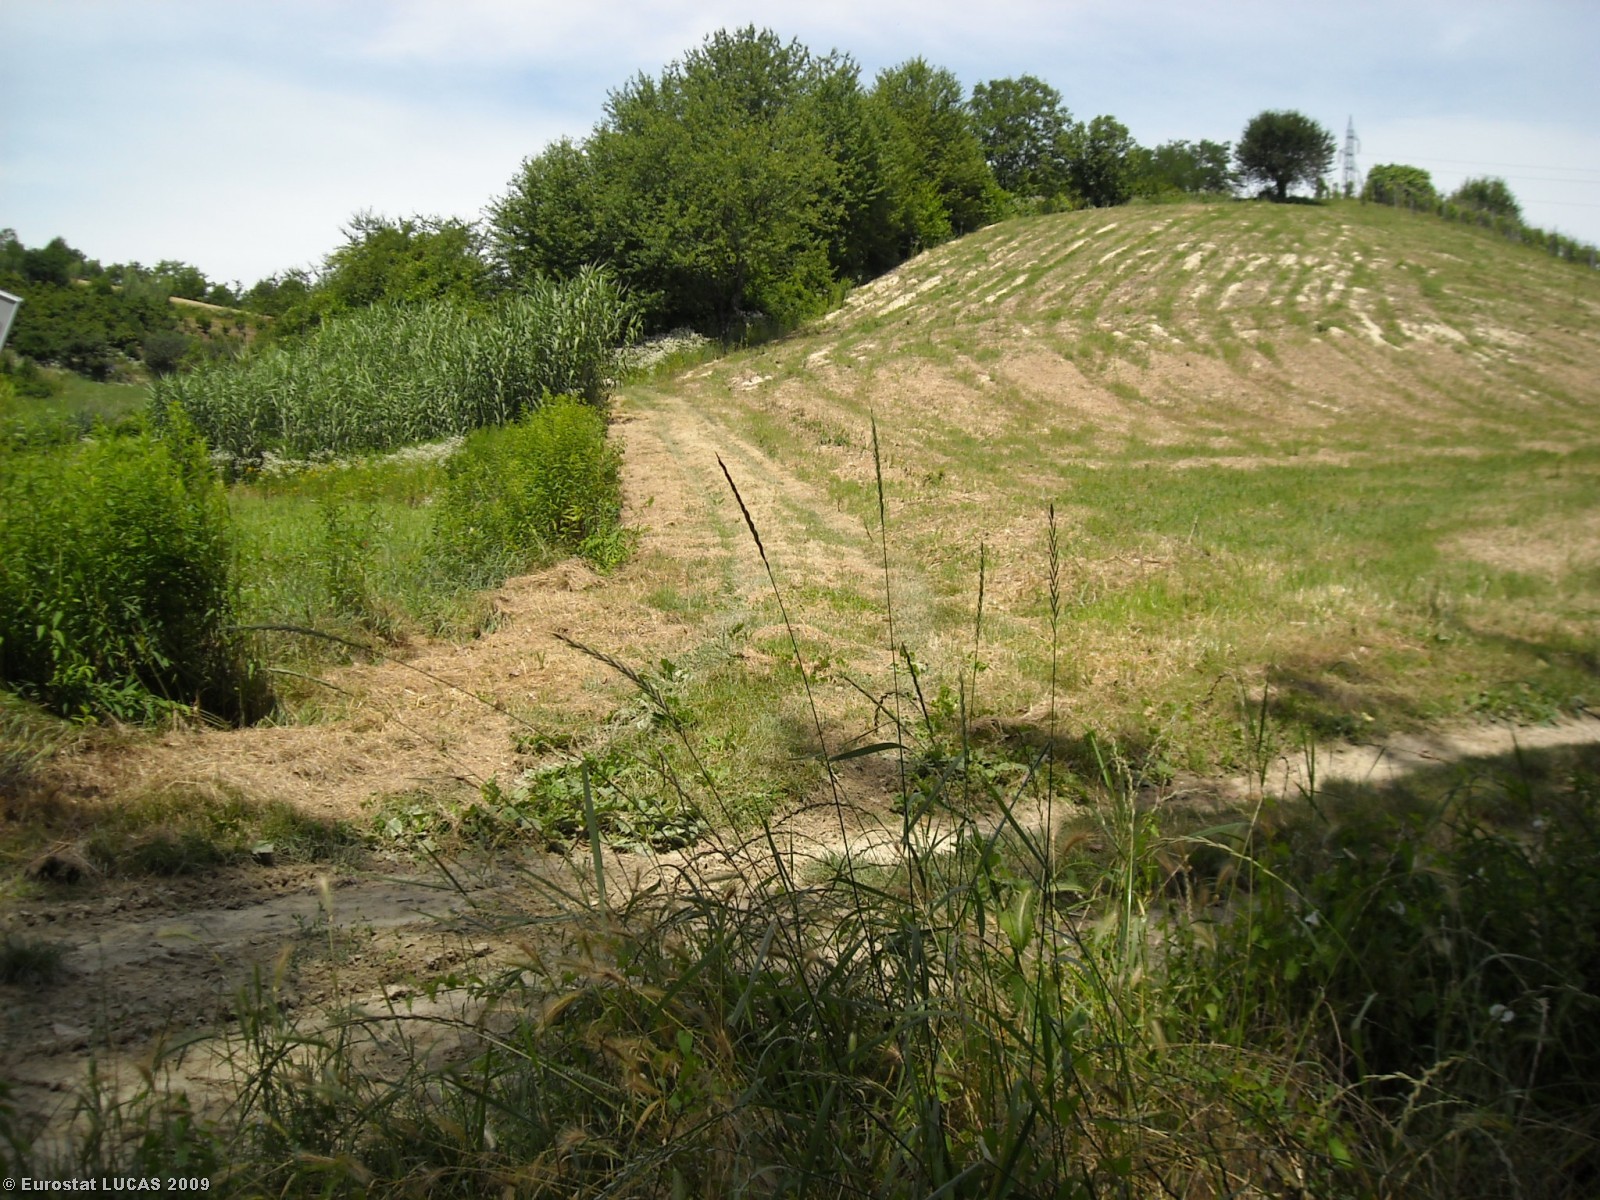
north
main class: Grassland
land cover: Spontaneously vegetated surfaces
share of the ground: > 75 %
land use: Fallow land
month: June
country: IT
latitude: 45.0003
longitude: 8.0880
